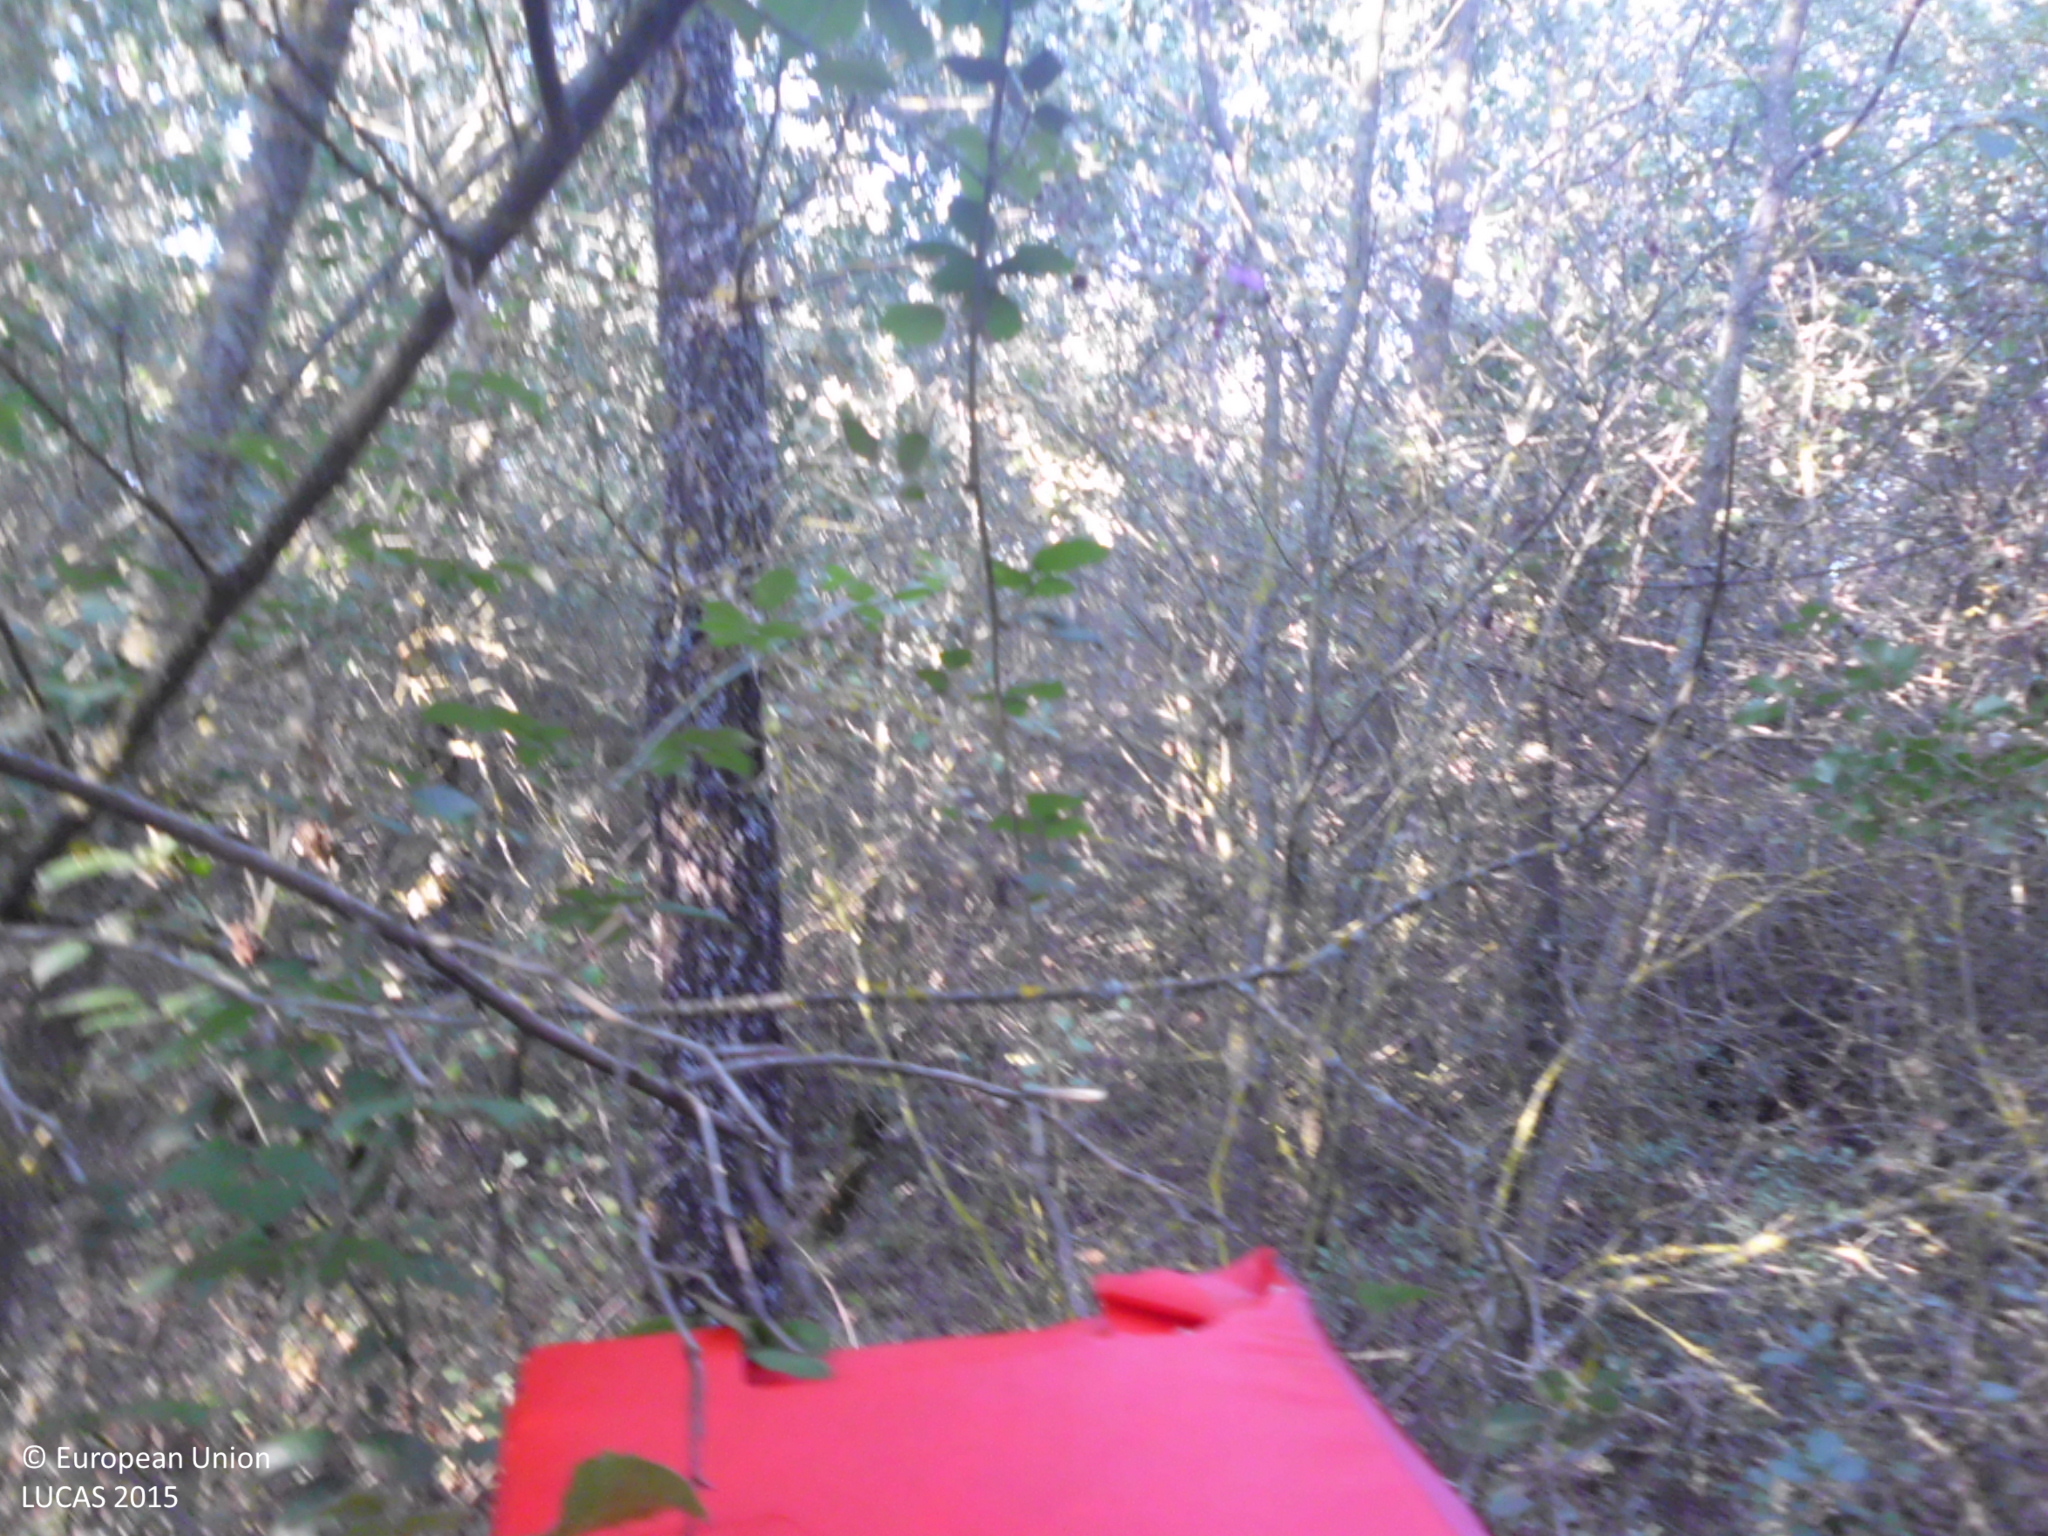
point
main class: Woodland
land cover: Broadleaved woodland
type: broadleaved evergreen forest
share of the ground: > 75 %
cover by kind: broadleaved forest trees 100 %
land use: Forestry
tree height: > 5 m
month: July
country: ES
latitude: 42.2736
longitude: -3.6510
